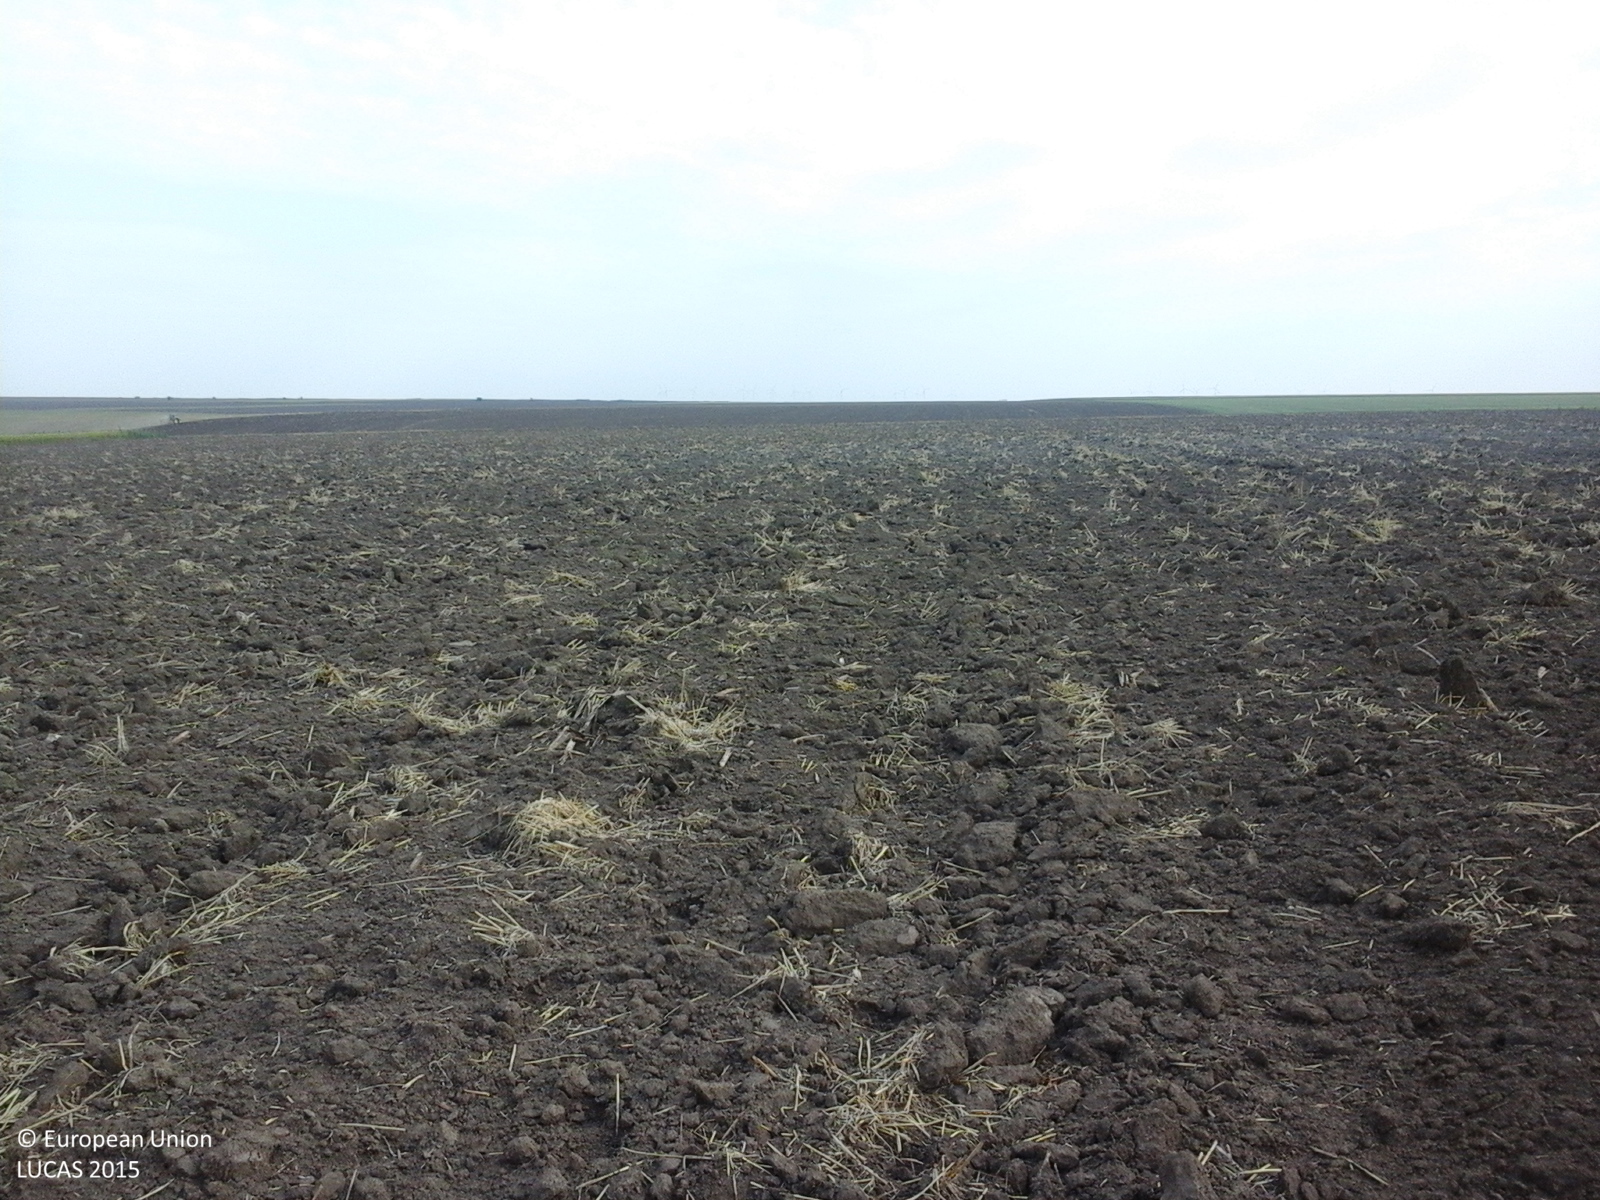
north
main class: Cropland
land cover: Common wheat
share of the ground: < 10 %
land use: Agriculture (excluding fallow land and kitchen gardens)
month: August
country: RO
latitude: 43.8053
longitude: 28.1404
